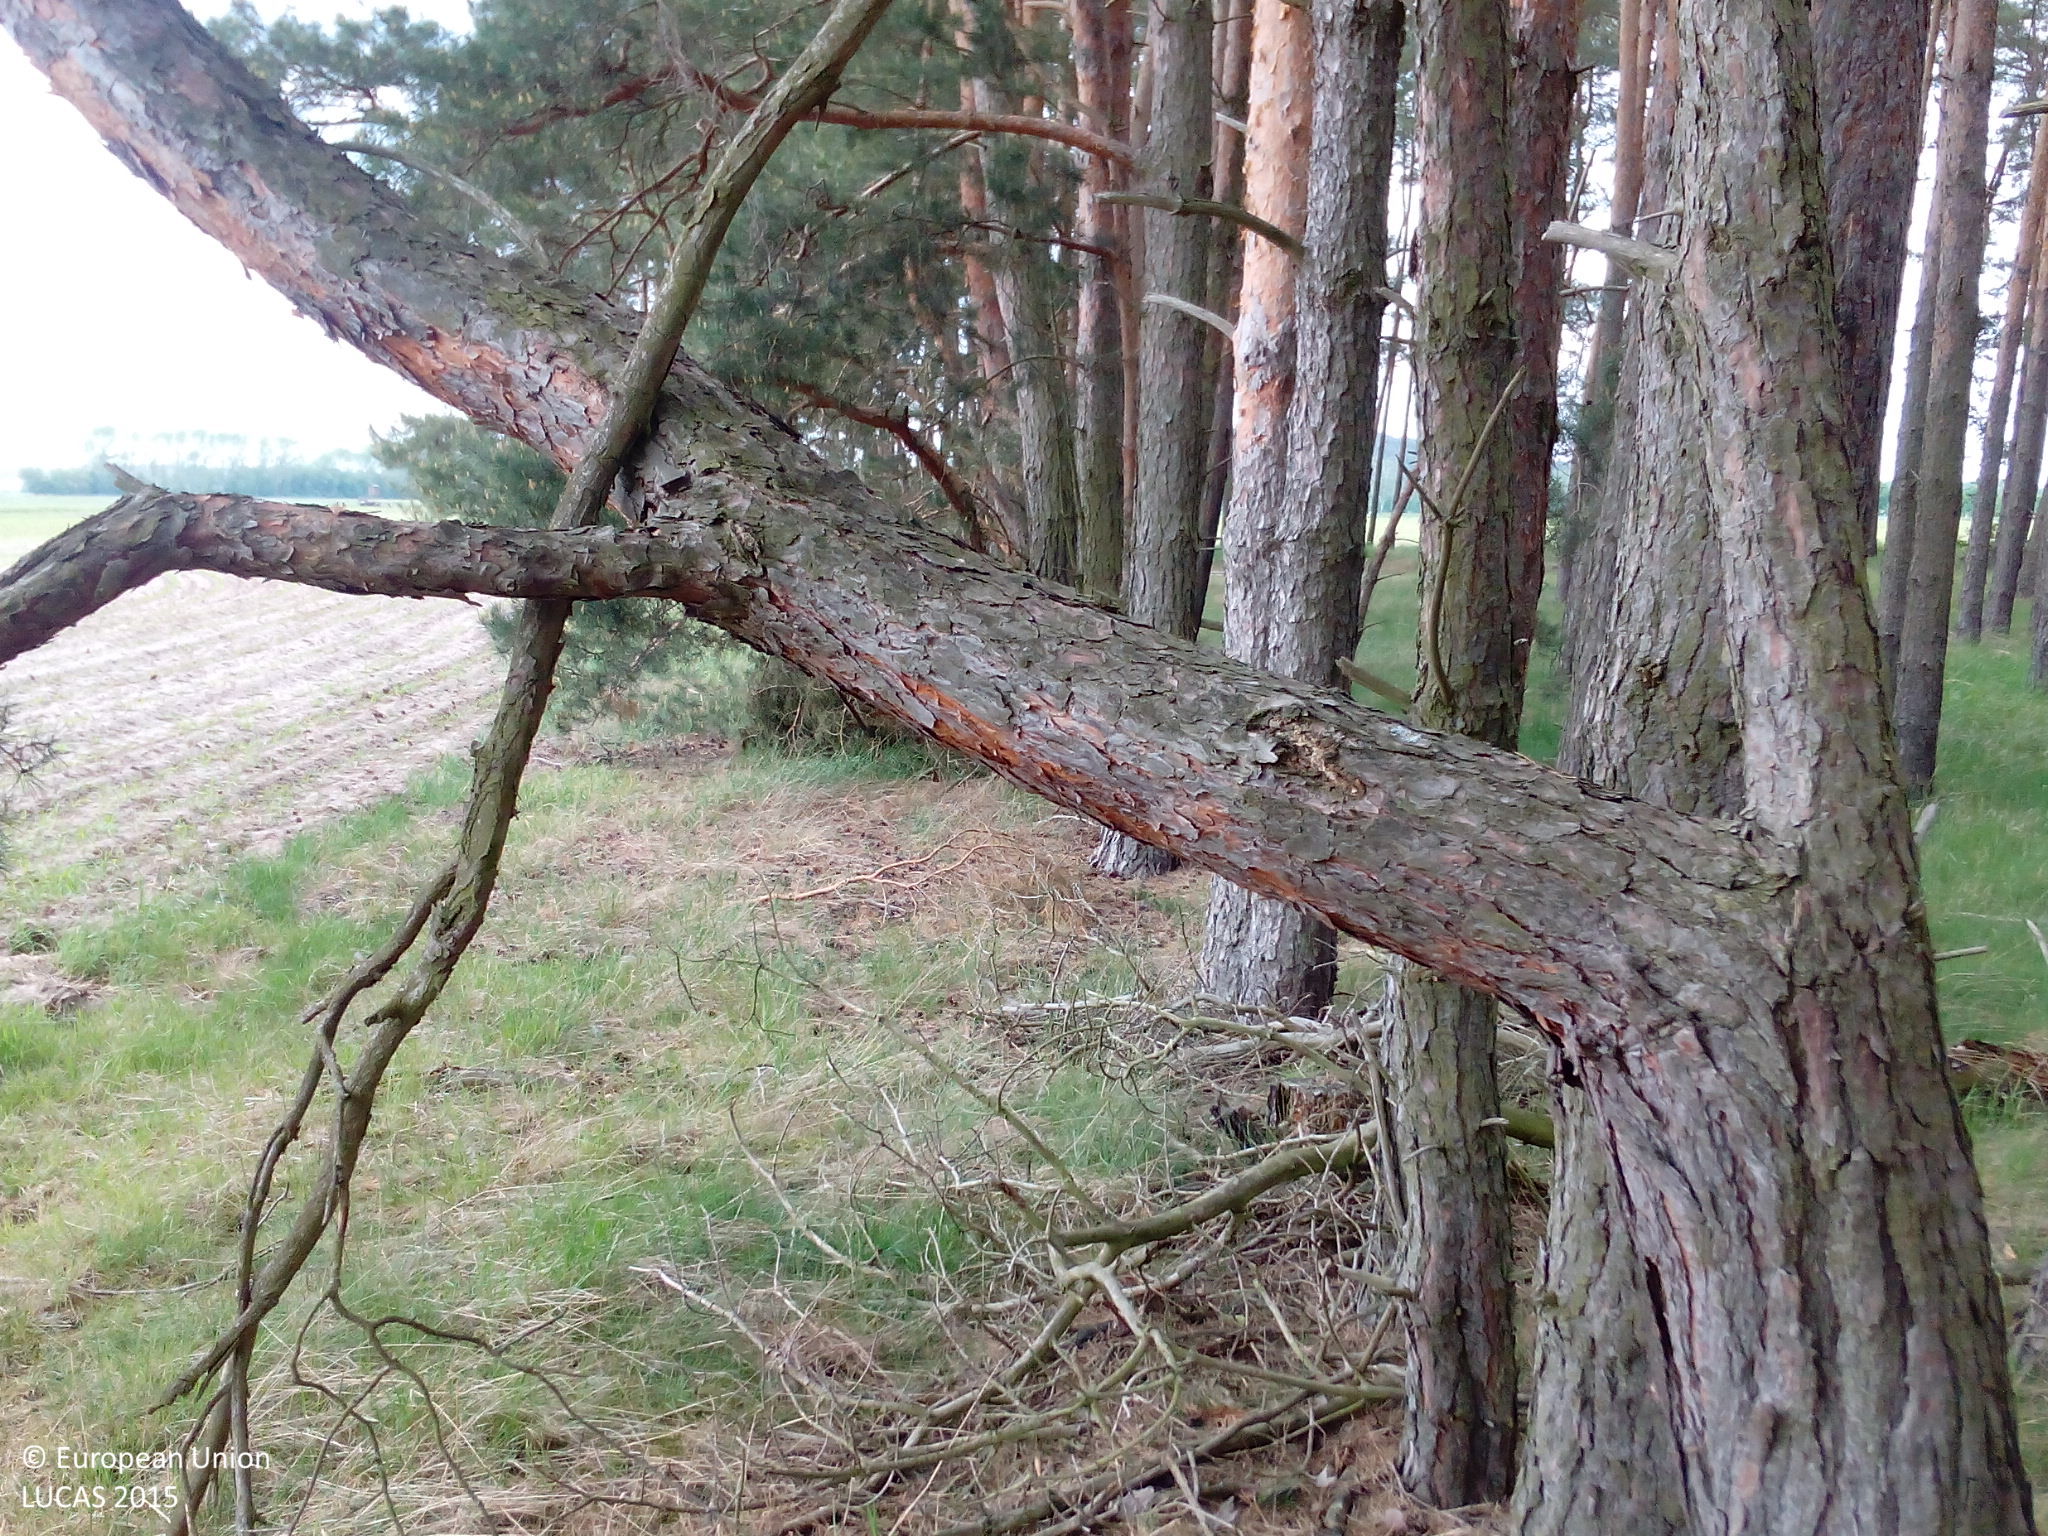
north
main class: Woodland
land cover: Pine dominated coniferous woodland
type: hemiboreal forest and nemoral coniferous forest and mixed broadleaved-coniferous forest
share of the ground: > 75 %
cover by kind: coniferous forest trees 80 %, herbaceous plants 15 %, unconsolidated bare surface 5 %
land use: Forestry
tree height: > 5 m
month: May
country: DE
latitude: 52.1732
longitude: 13.1731
